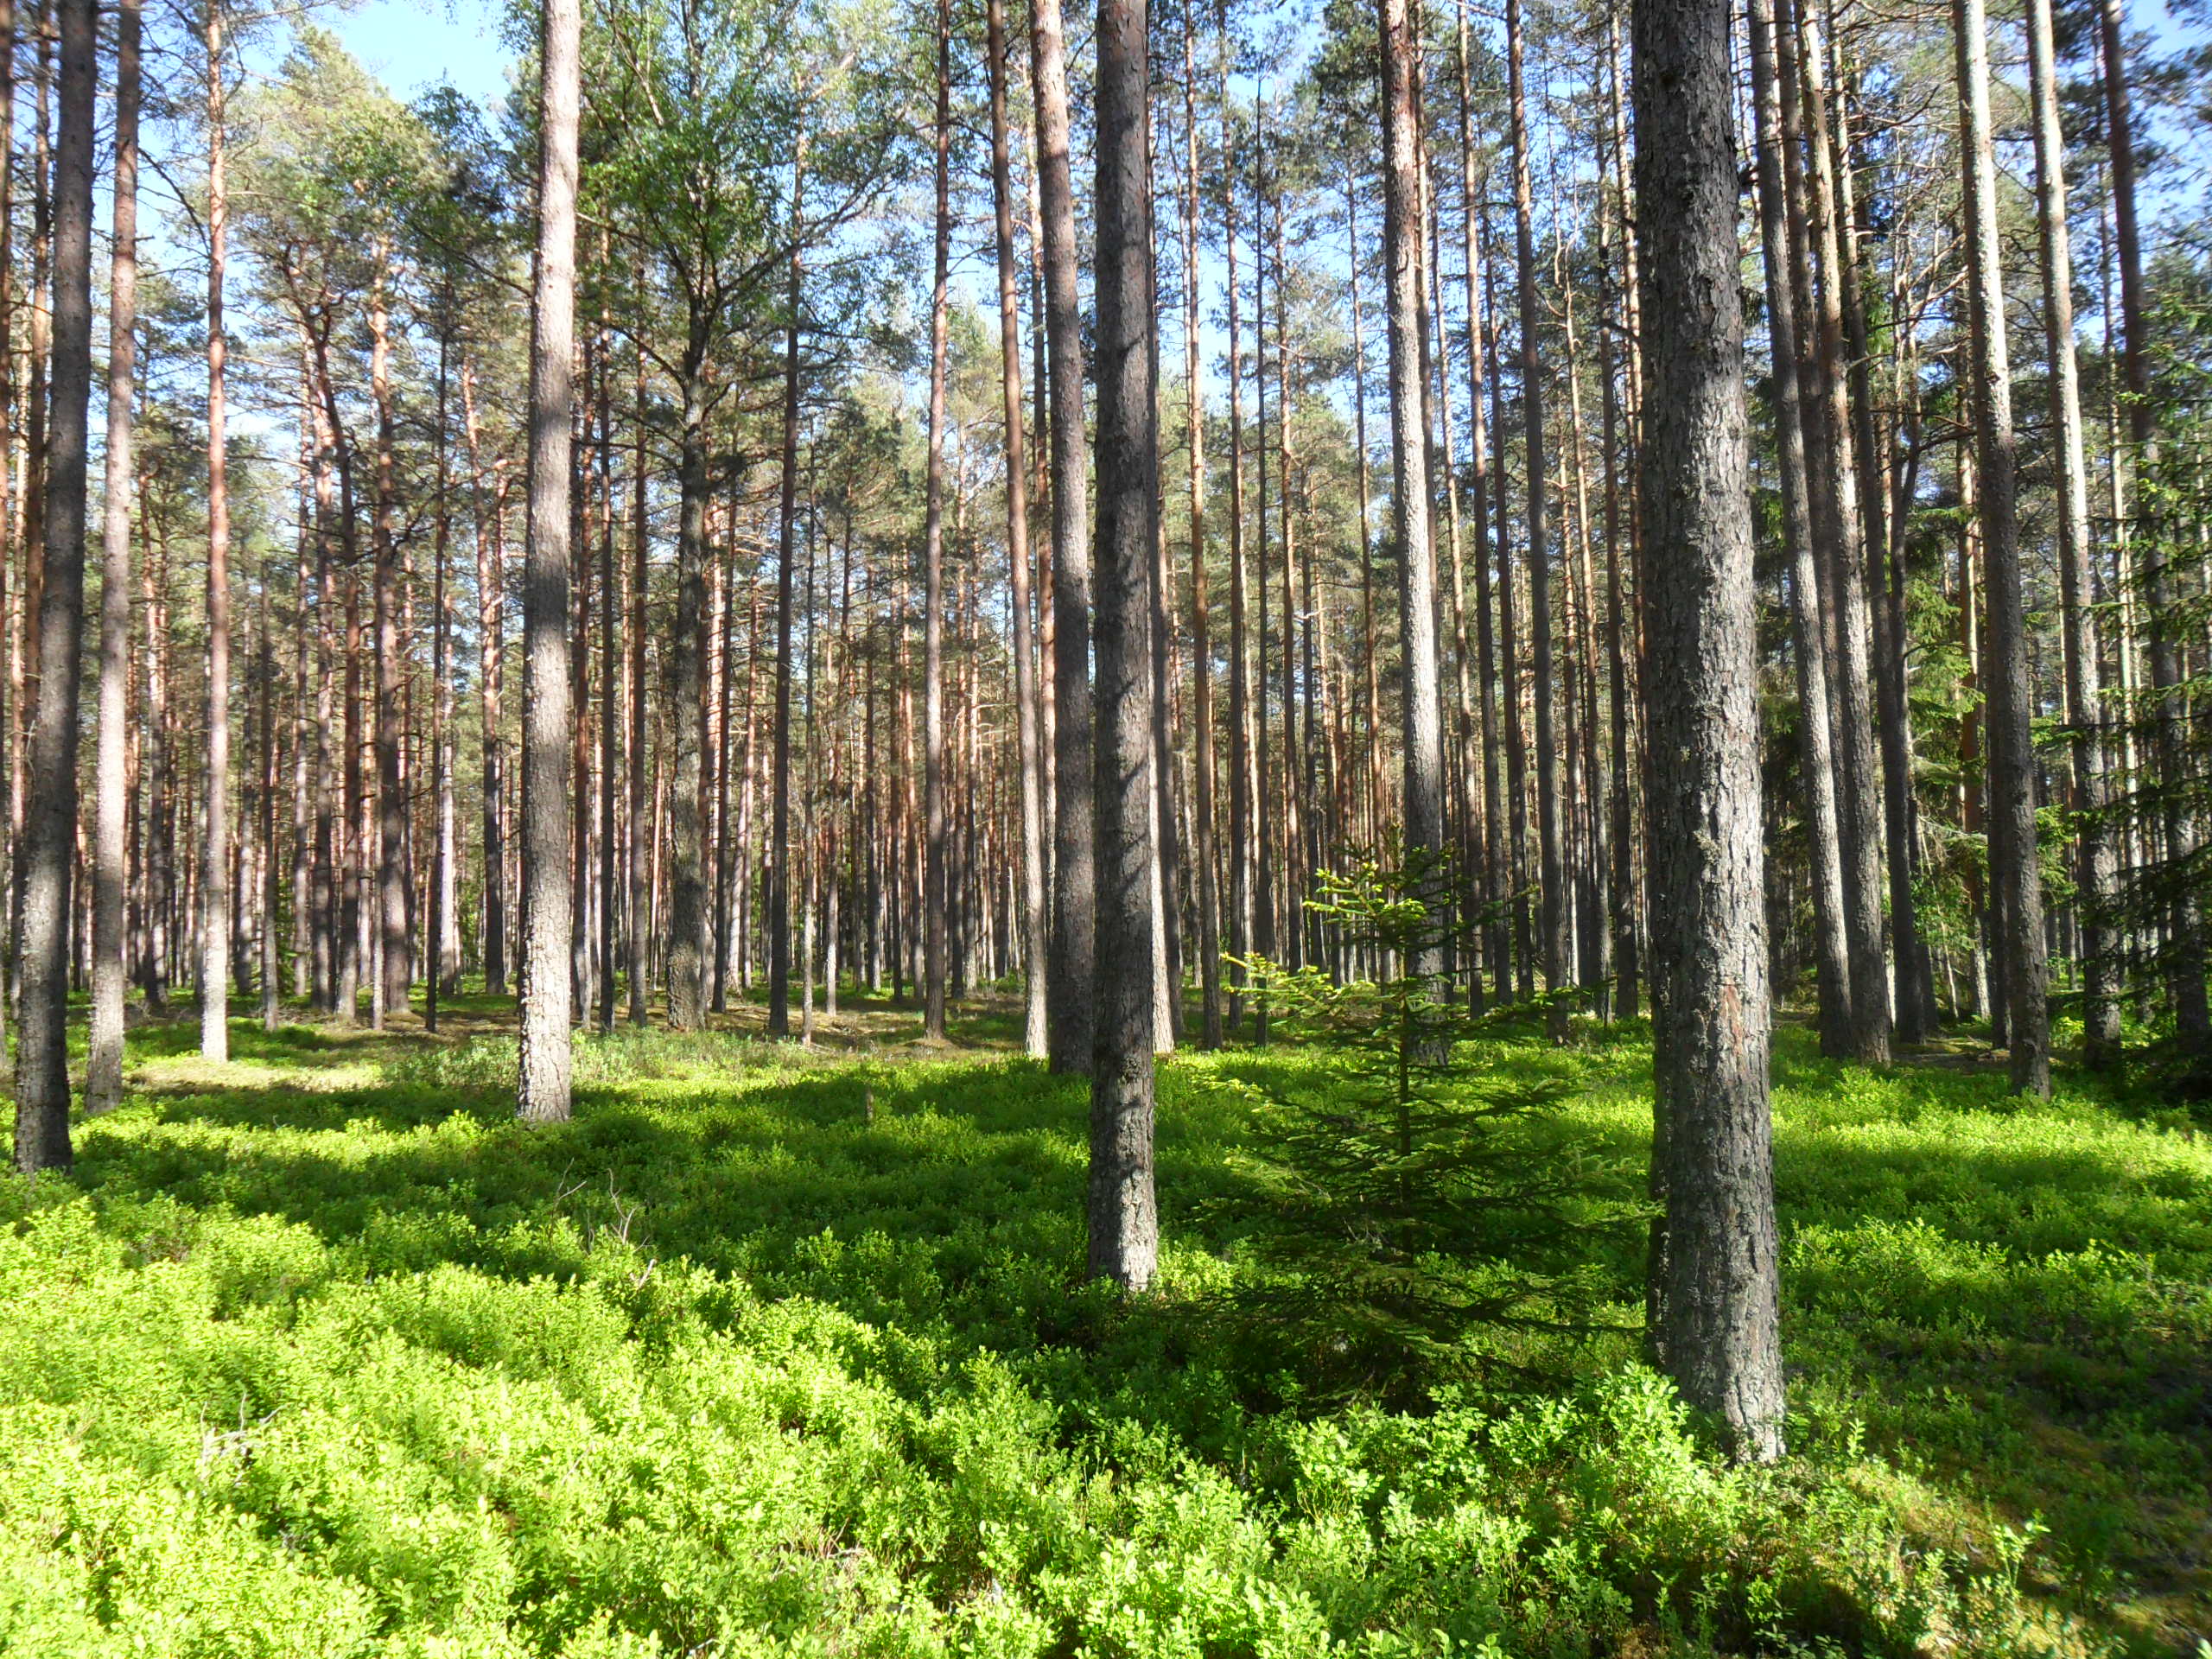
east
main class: Woodland
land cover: Pine dominated coniferous woodland
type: hemiboreal forest and nemoral coniferous forest and mixed broadleaved-coniferous forest
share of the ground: > 75 %
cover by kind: coniferous forest trees 90 %, herbaceous plants 10 %
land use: Forestry
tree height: > 5 m
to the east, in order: Pine dominated coniferous woodland; Paved roads, cycling and walking lanes; Pine dominated coniferous woodland; Ditches and canals; Other mixed woodland
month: June
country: LV
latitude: 57.5667
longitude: 22.2355
